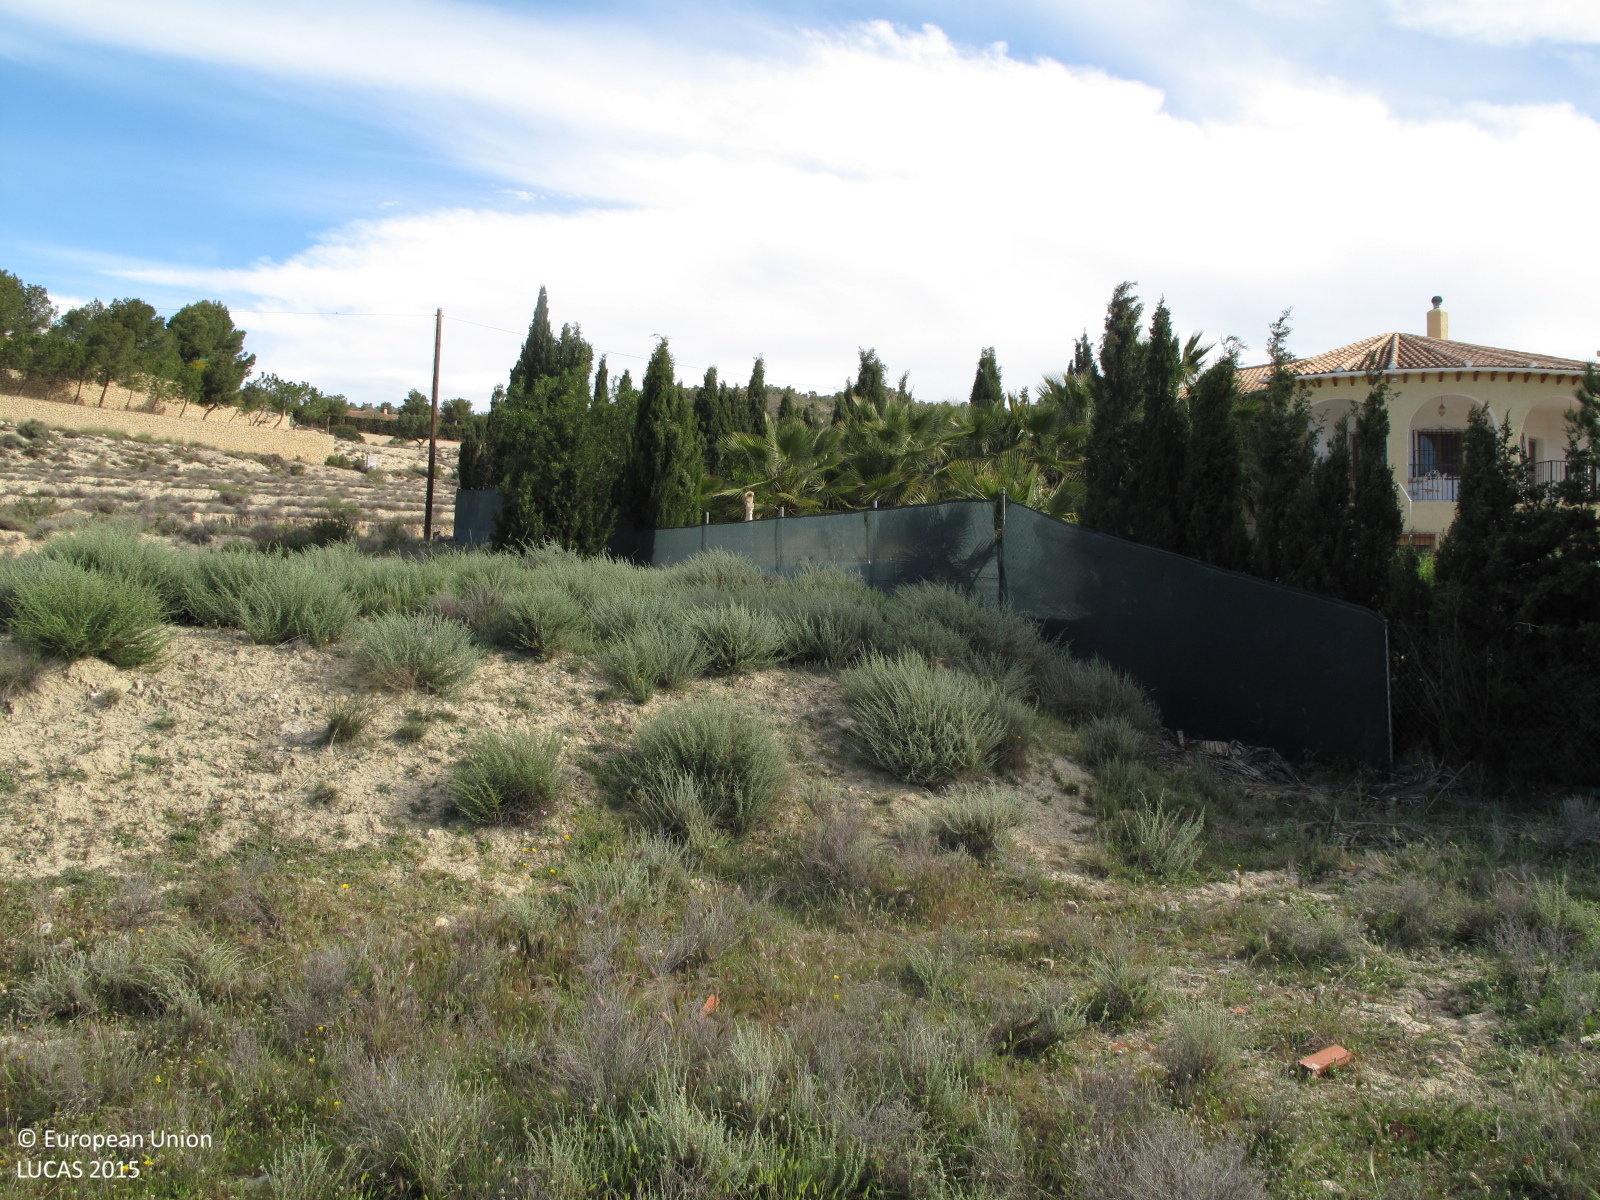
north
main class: Shrubland
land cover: Shrubland without tree cover
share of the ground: 50 - 75 %
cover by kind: shrubs 60 %, herbaceous plants 25 %, consolidated bare surface 15 %
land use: Abandoned areas
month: April
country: ES
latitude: 38.5543
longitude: -0.4874
